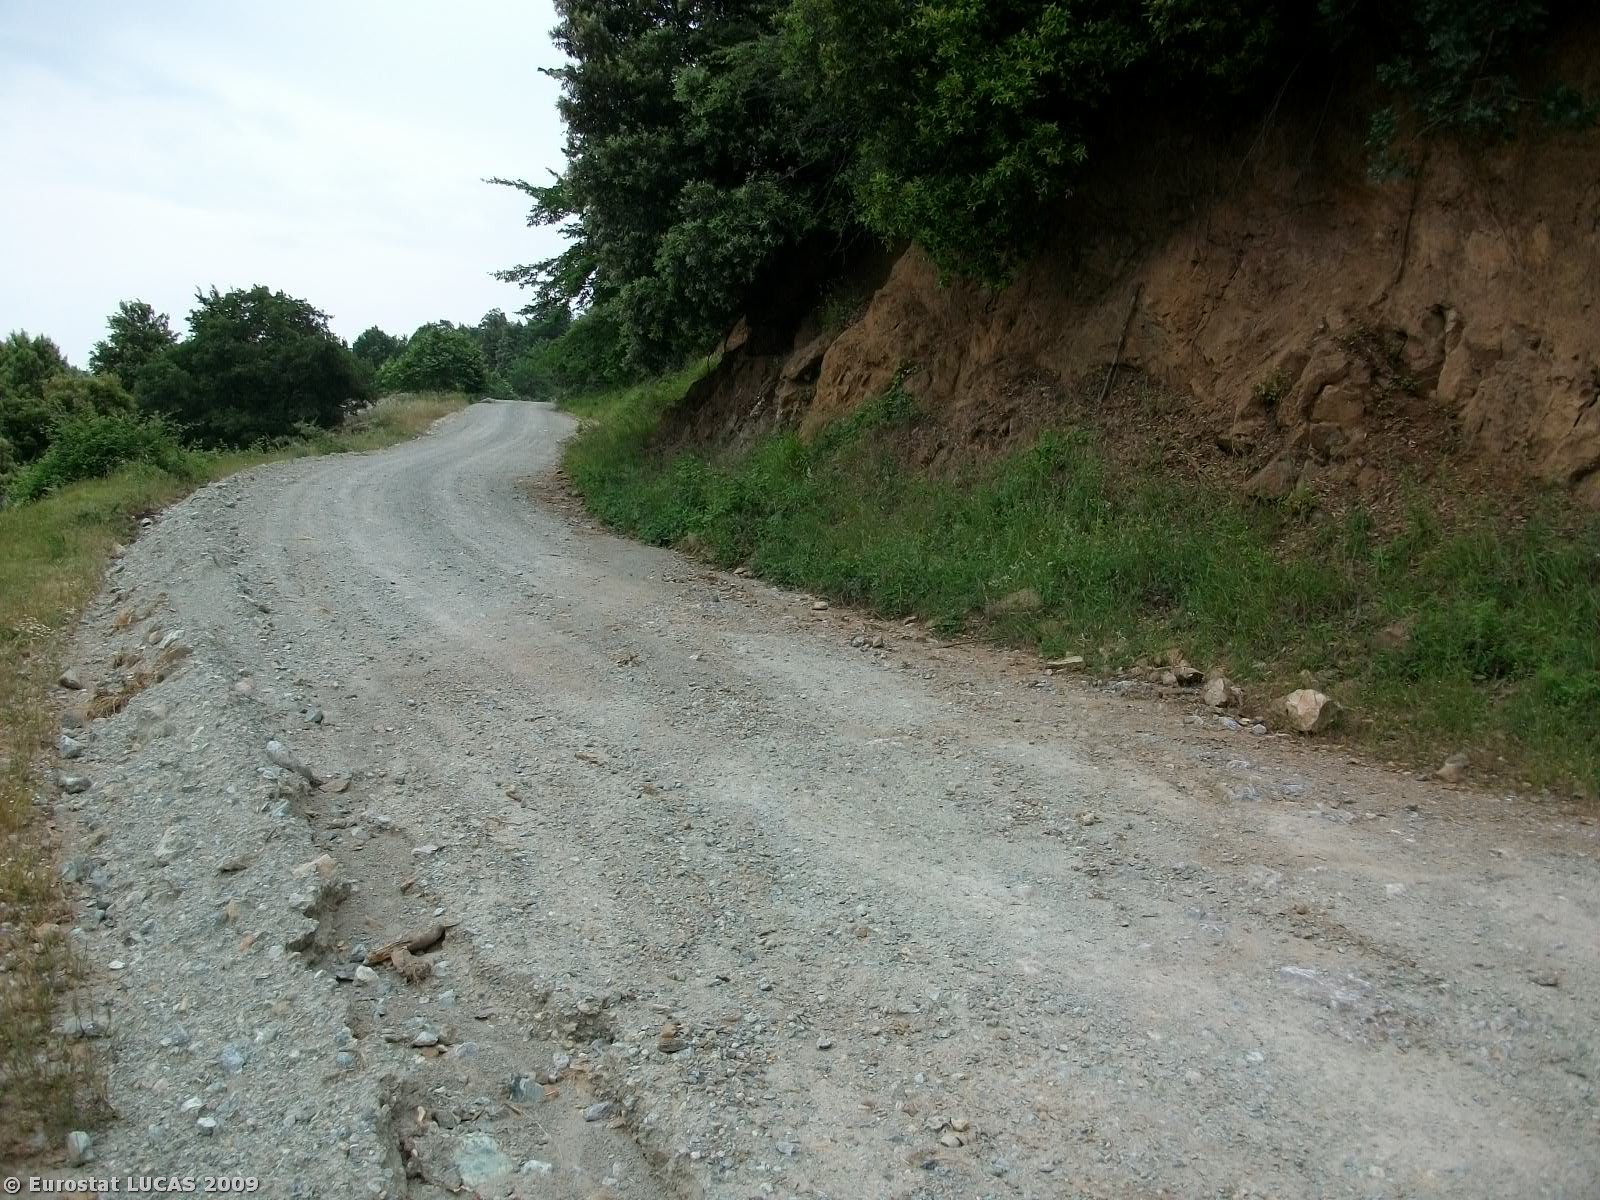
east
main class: Woodland
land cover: Broadleaved woodland
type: thermophilous deciduous forest
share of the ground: > 75 %
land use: Forestry
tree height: > 5 m
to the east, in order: Broadleaved woodland; Grassland with sparse tree/shrub cover
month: June
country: GR
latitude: 39.6625
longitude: 22.8039
